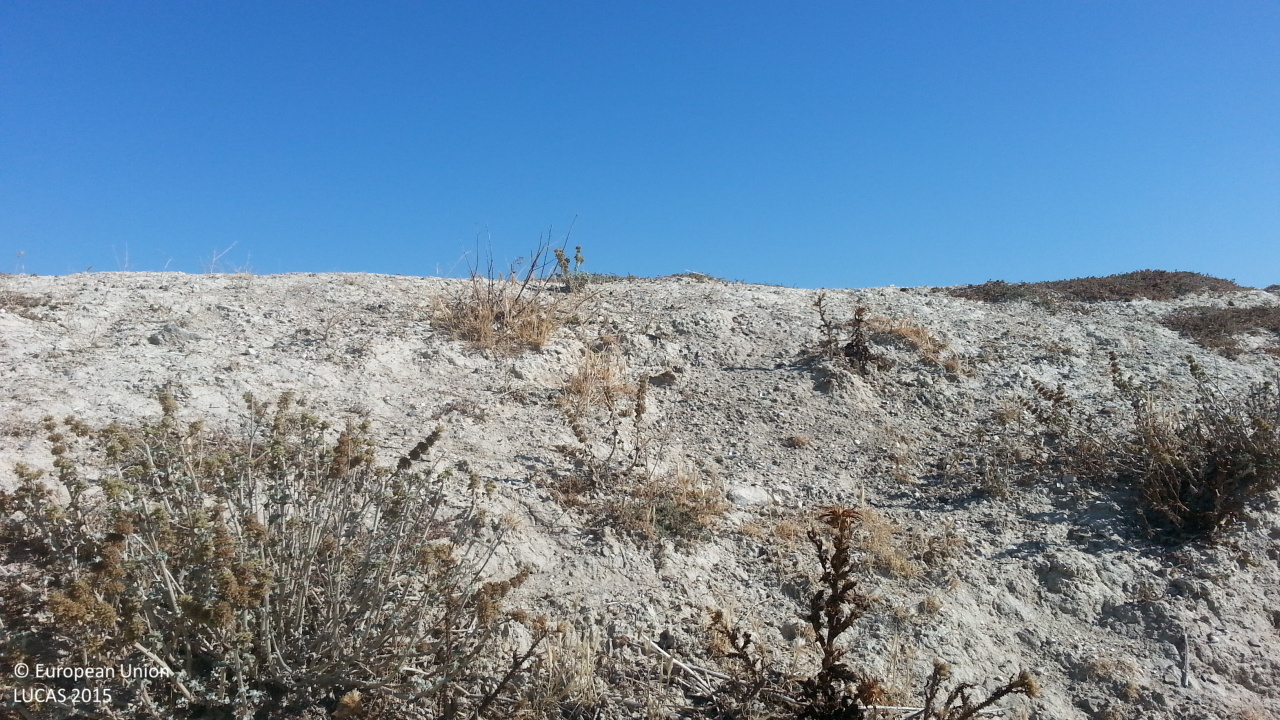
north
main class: Shrubland
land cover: Shrubland without tree cover
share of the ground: 50 - 75 %
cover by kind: shrubs 50 %, unconsolidated bare surface 45 %, herbaceous plants 5 %
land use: Agriculture (excluding fallow land and kitchen gardens)
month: June
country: ES
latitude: 36.9948
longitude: -5.9827
